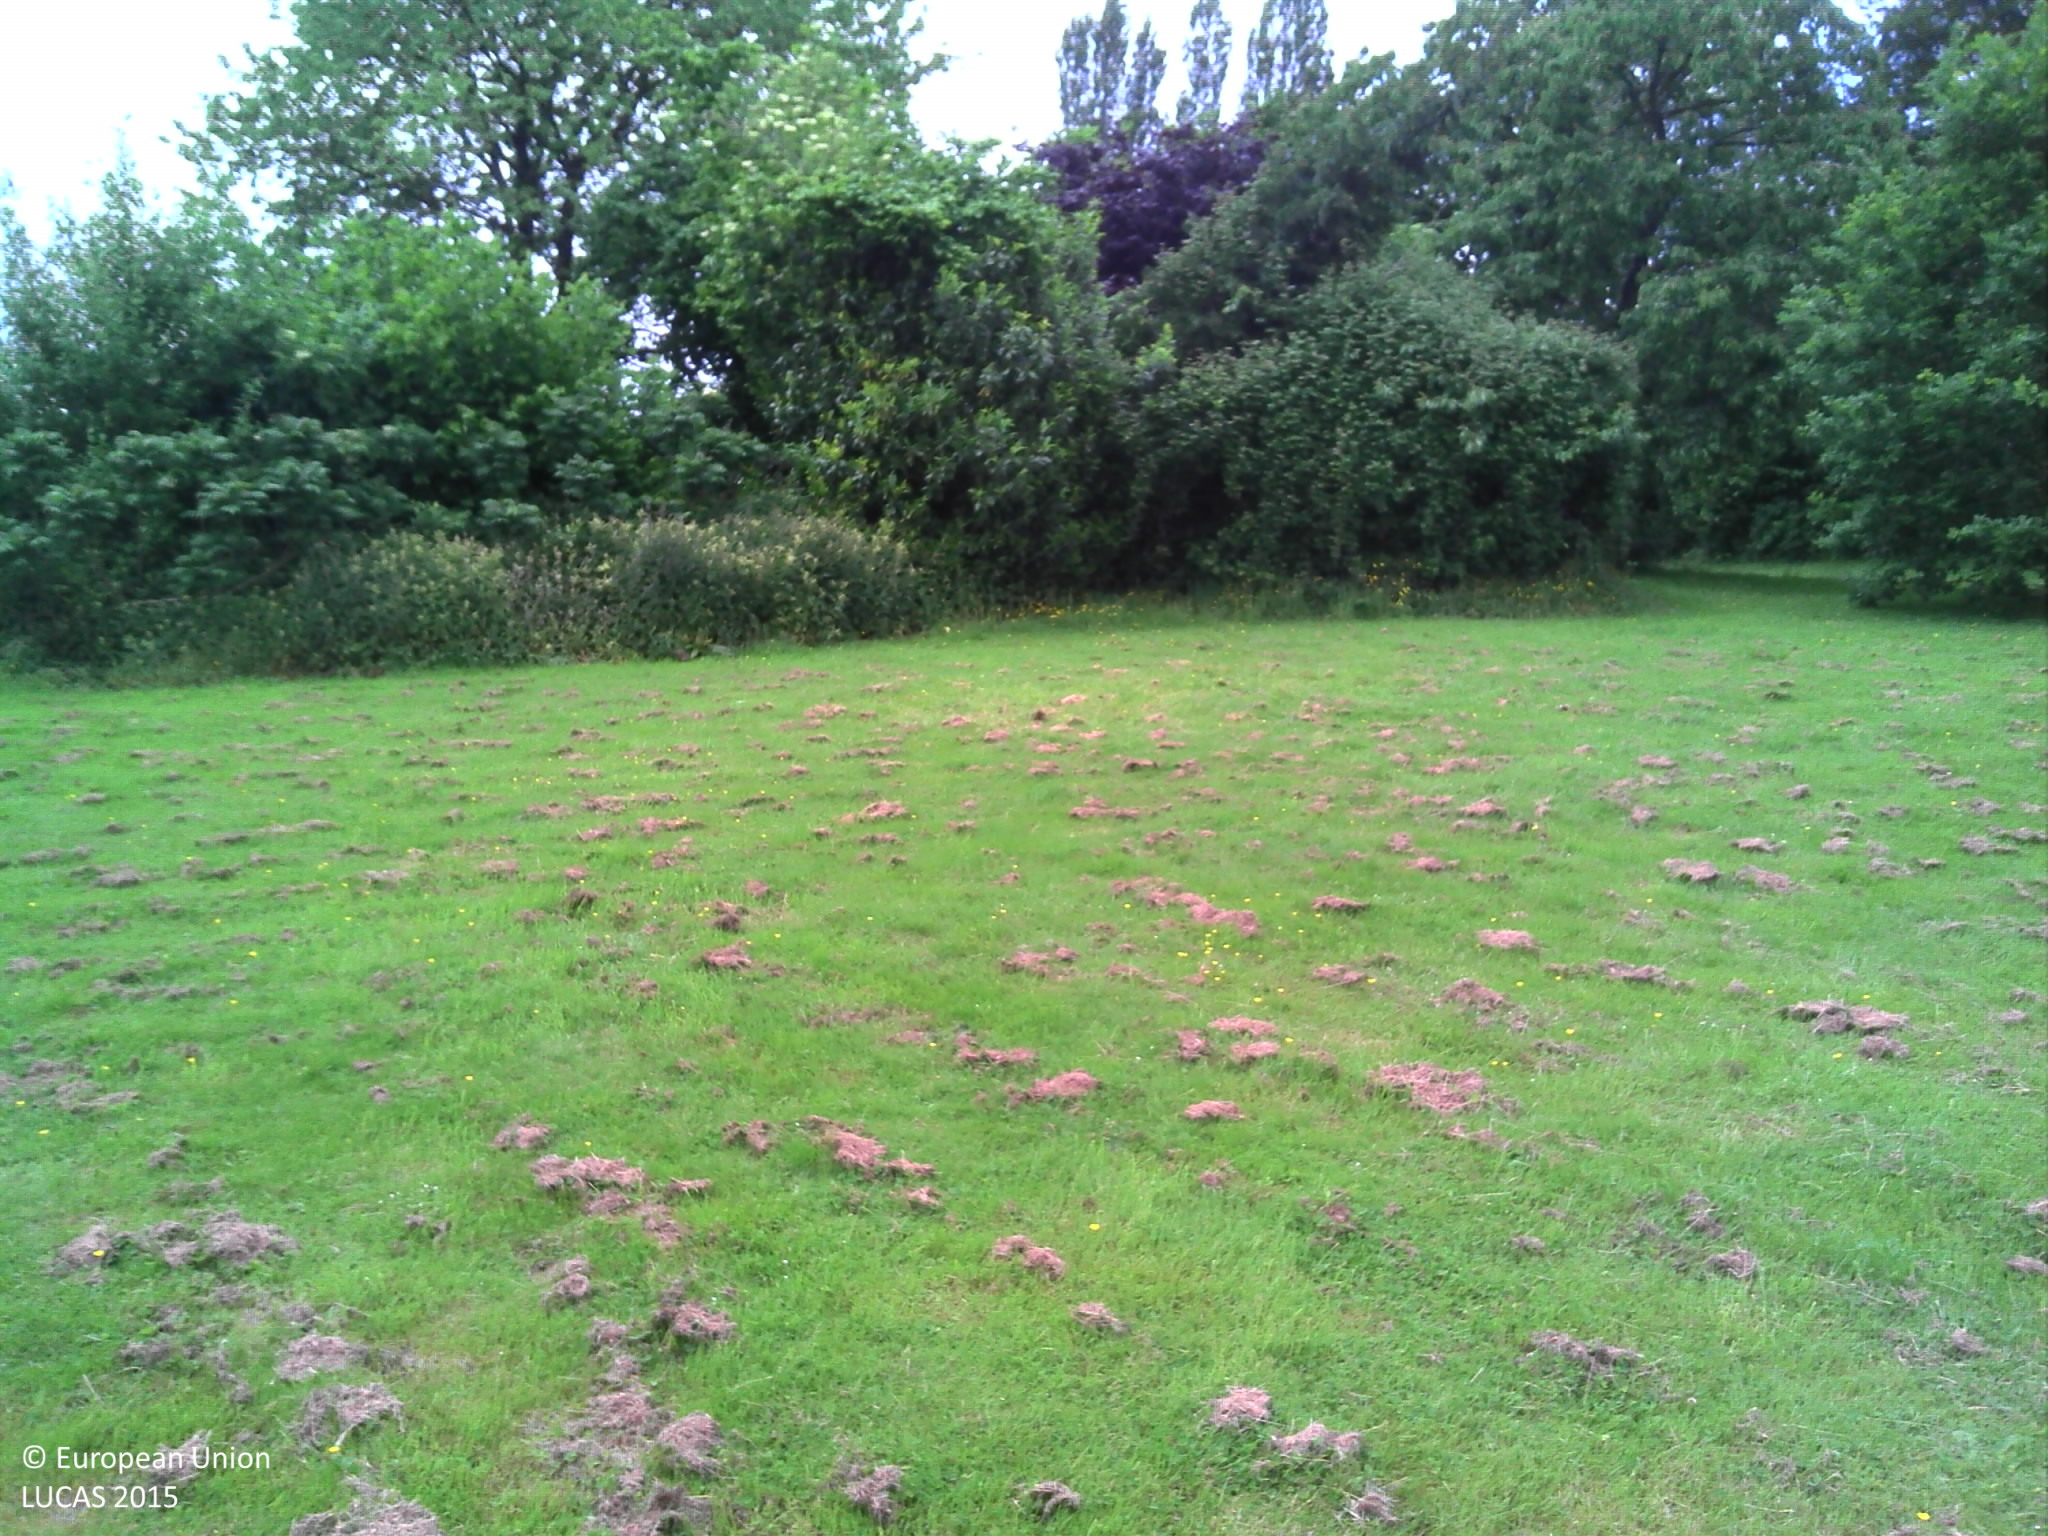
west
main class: Grassland
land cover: Grassland with sparse tree/shrub cover
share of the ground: > 75 %
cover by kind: herbaceous plants 95 %, broadleaved forest trees 5 %
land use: Agriculture (excluding fallow land and kitchen gardens)
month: June
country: BE
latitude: 50.8504
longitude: 3.9003
